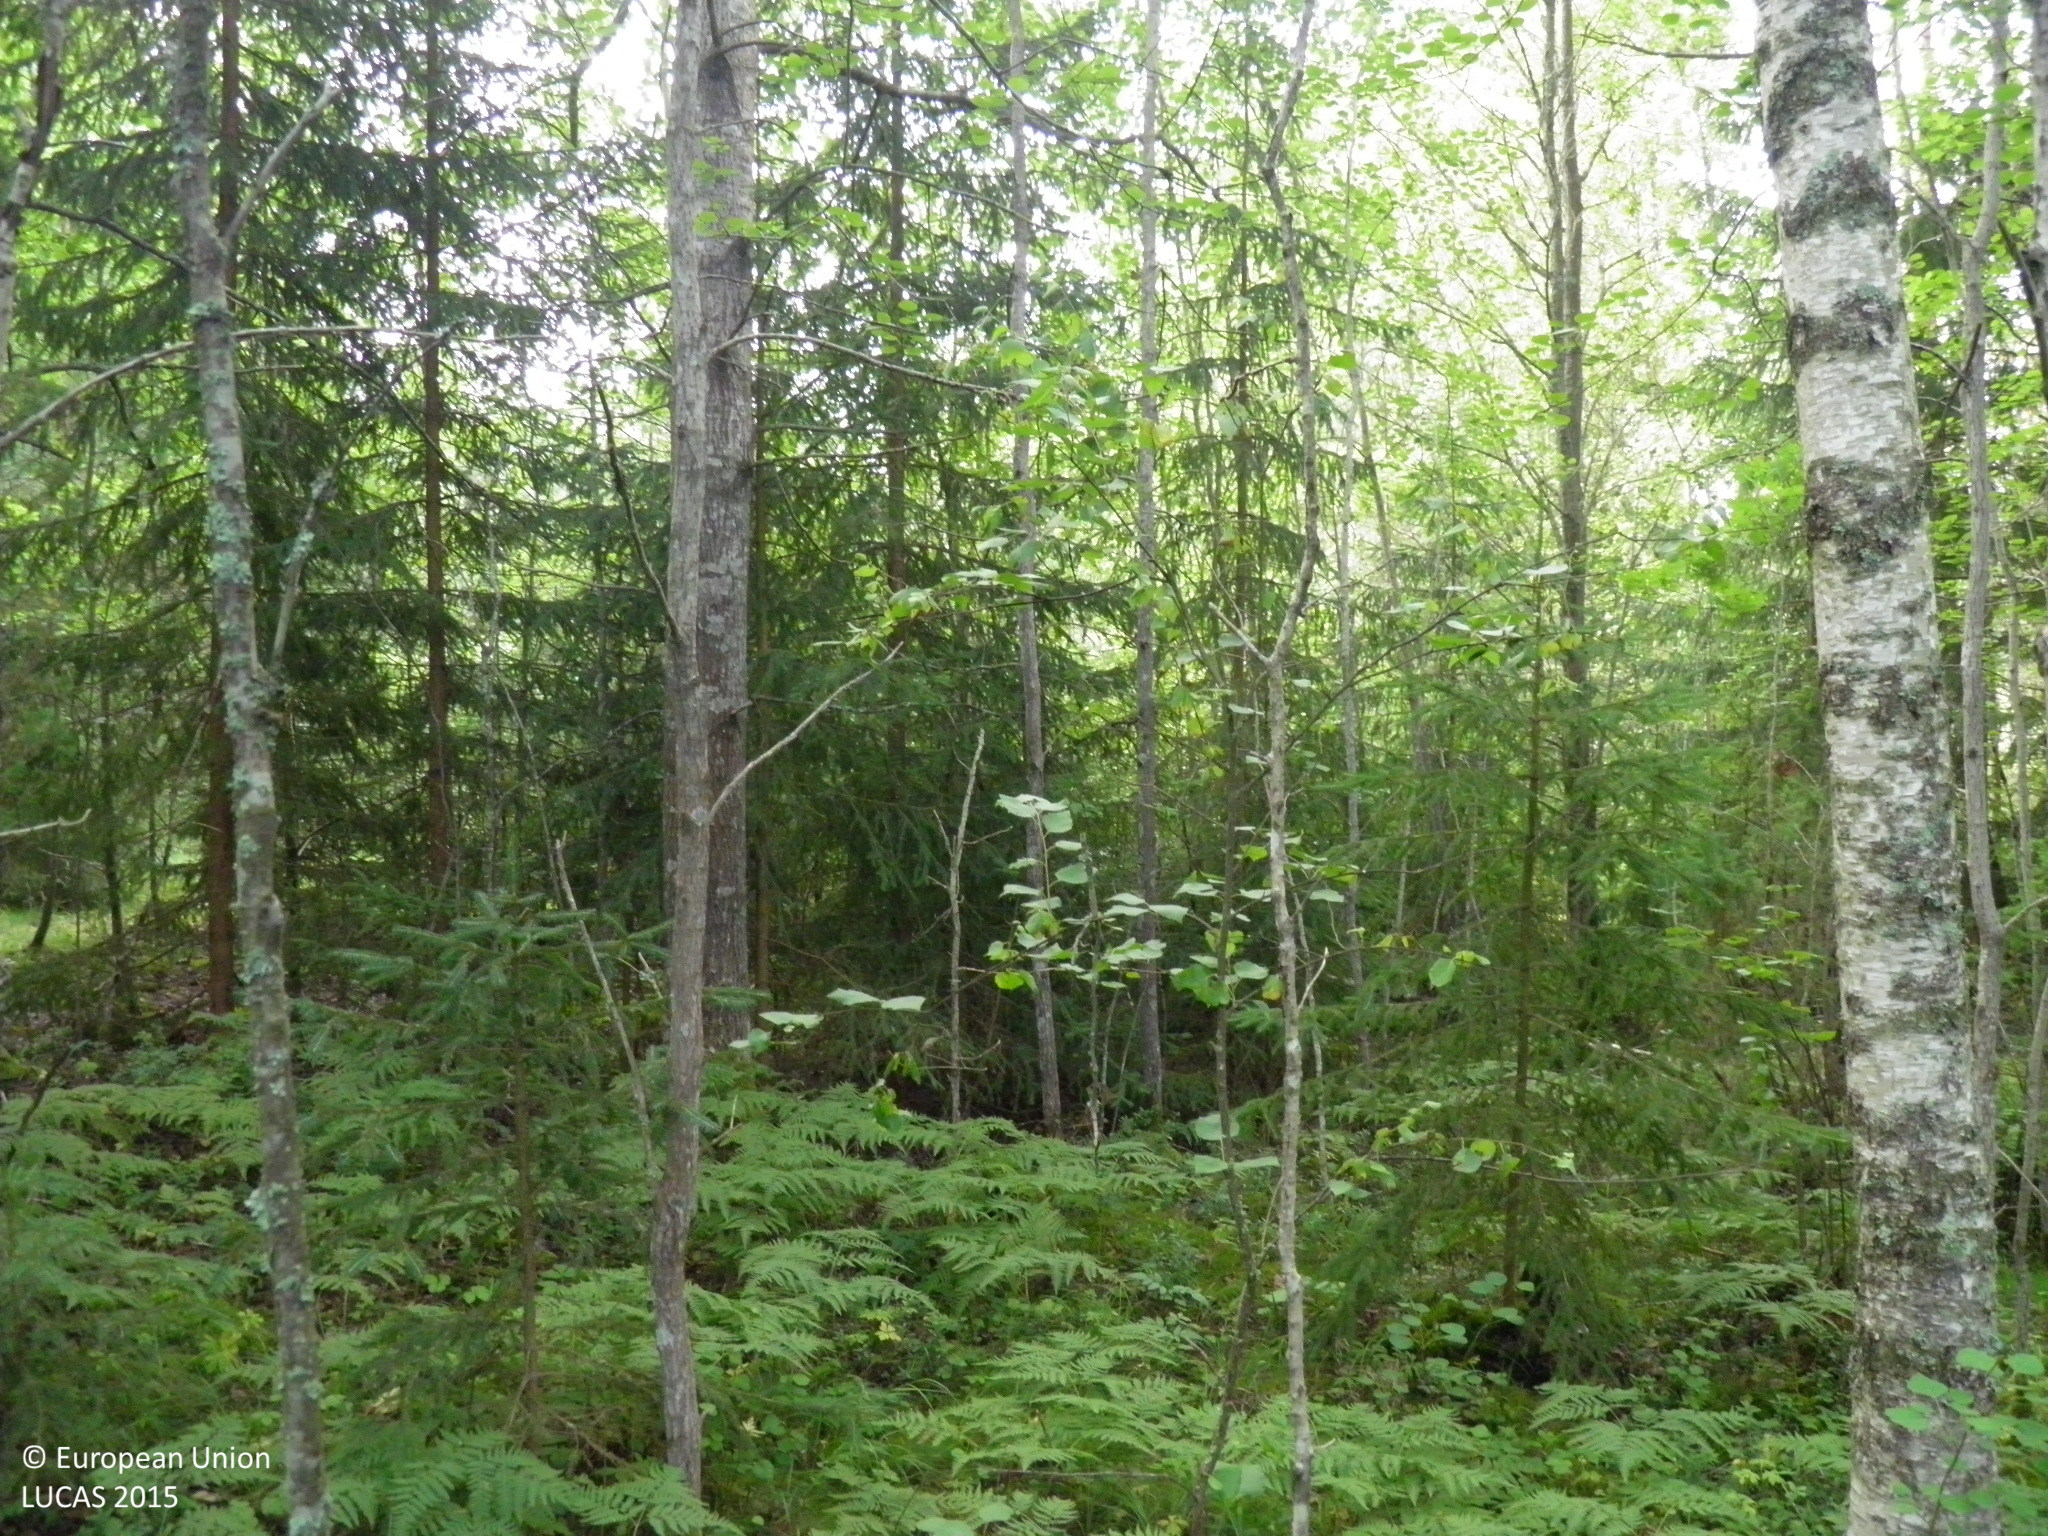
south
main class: Woodland
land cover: Pine dominated mixed woodland
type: hemiboreal forest and nemoral coniferous forest and mixed broadleaved-coniferous forest
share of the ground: > 75 %
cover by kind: broadleaved forest trees 45 %, coniferous forest trees 35 %, shrubs 10 %, herbaceous plants 5 %, lichens and mosses 5 %
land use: Forestry
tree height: > 5 m
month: July
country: FI
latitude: 60.0921
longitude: 22.7527
